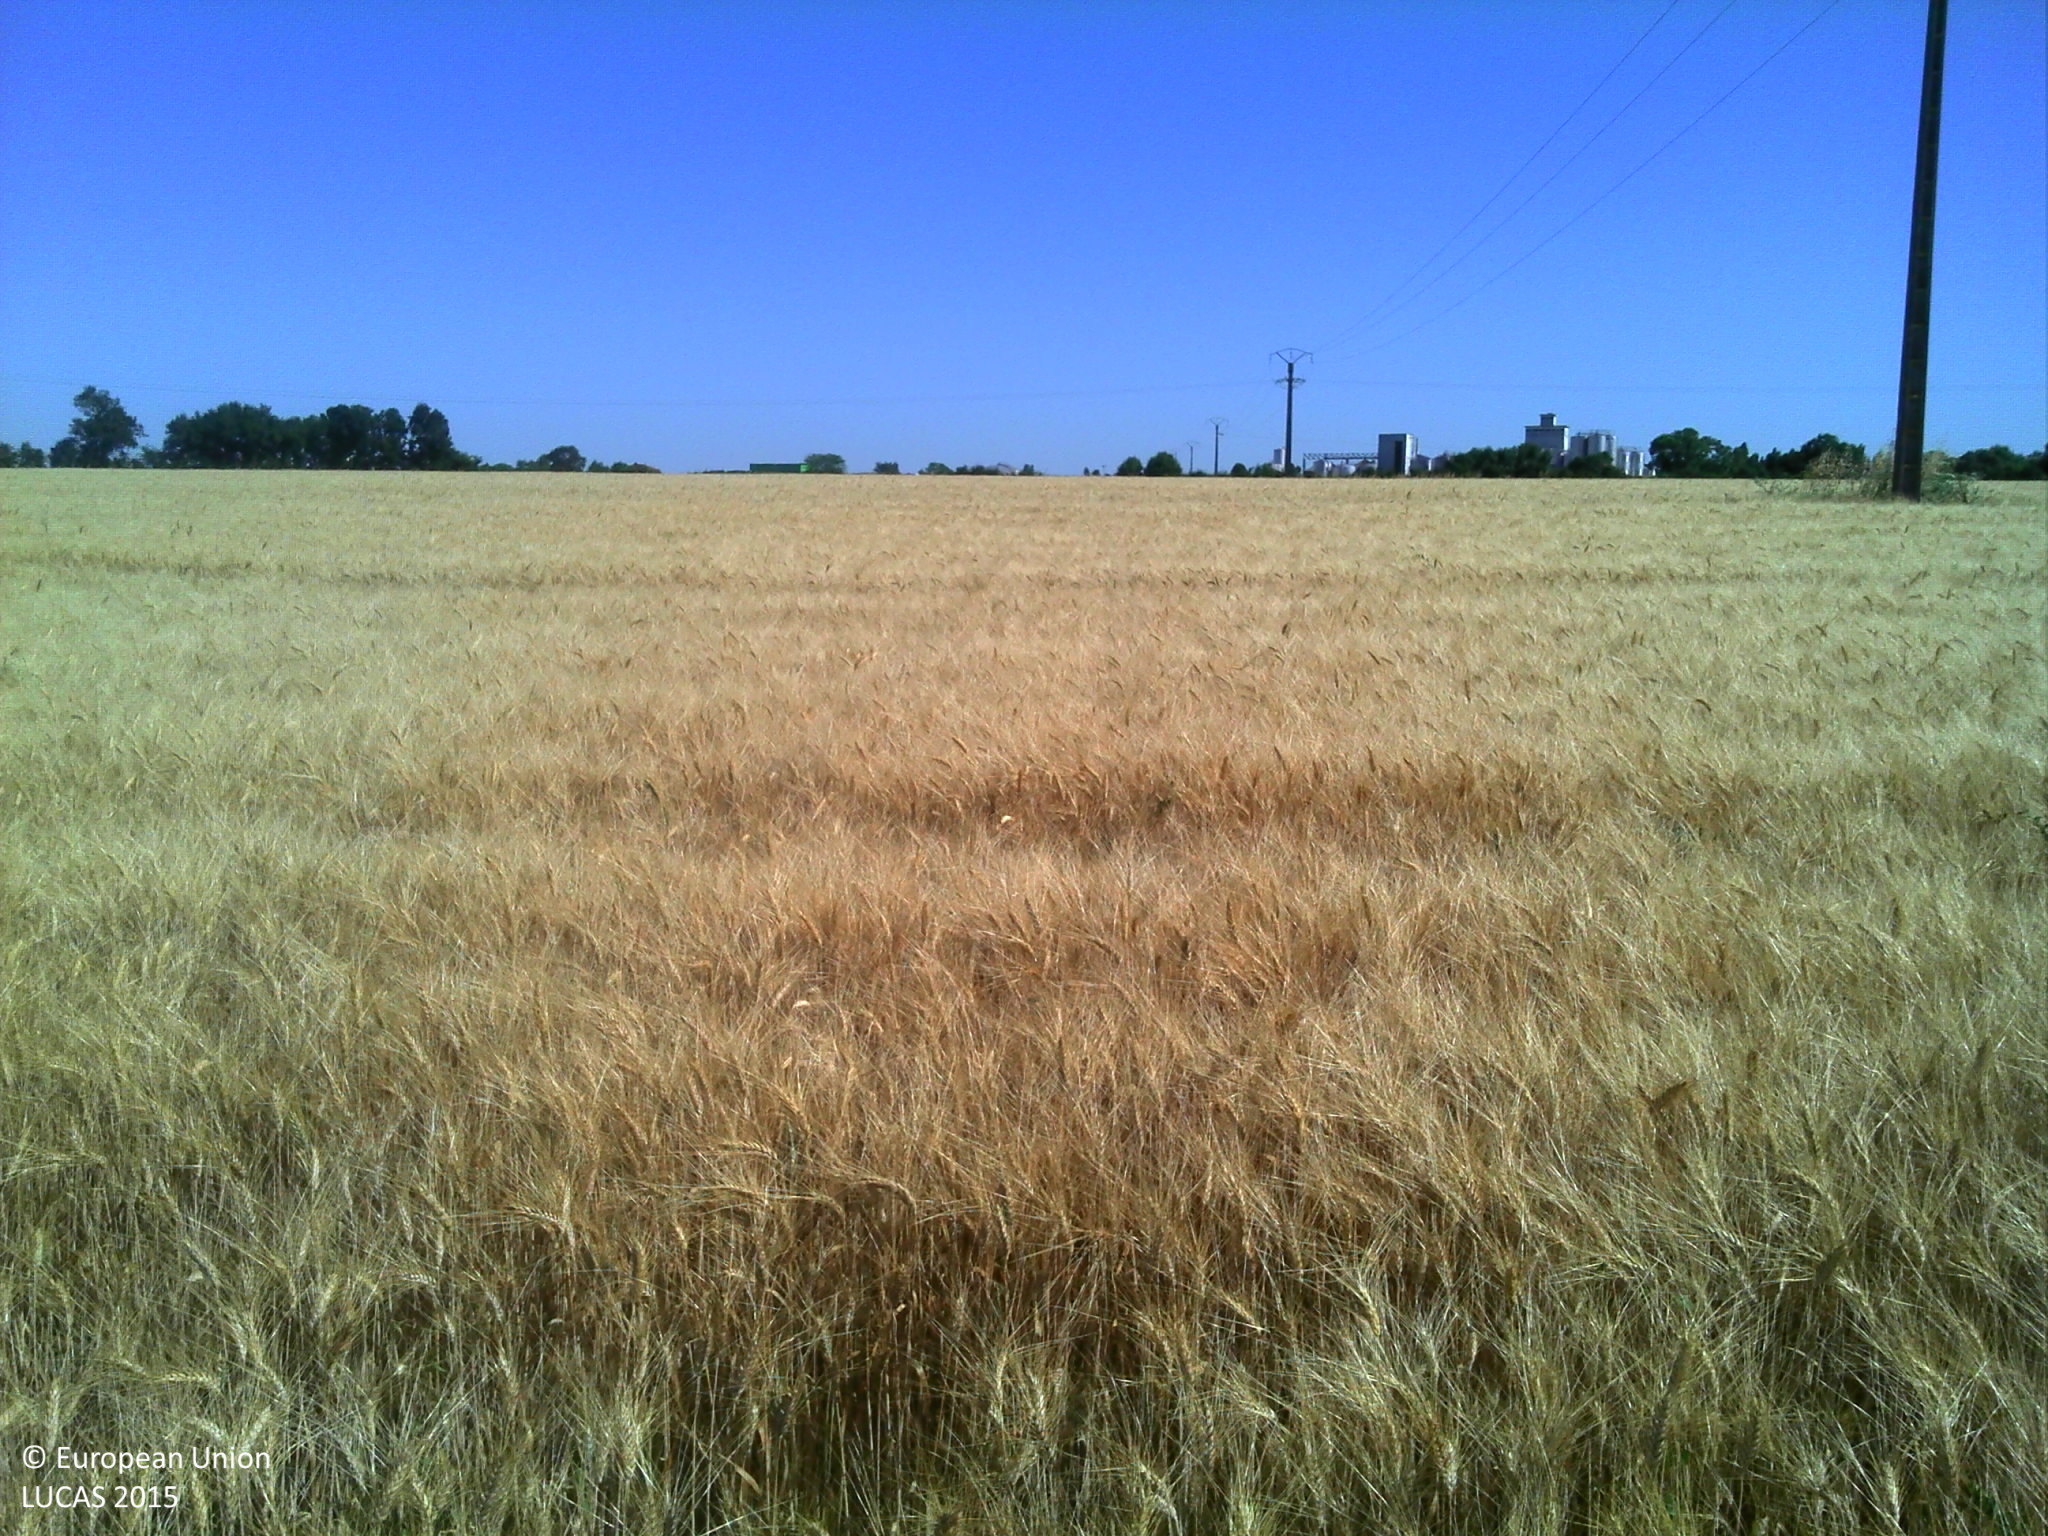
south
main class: Cropland
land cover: Durum wheat
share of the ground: > 75 %
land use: Agriculture (excluding fallow land and kitchen gardens)
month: June
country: FR
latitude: 45.5795
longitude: -0.6735
